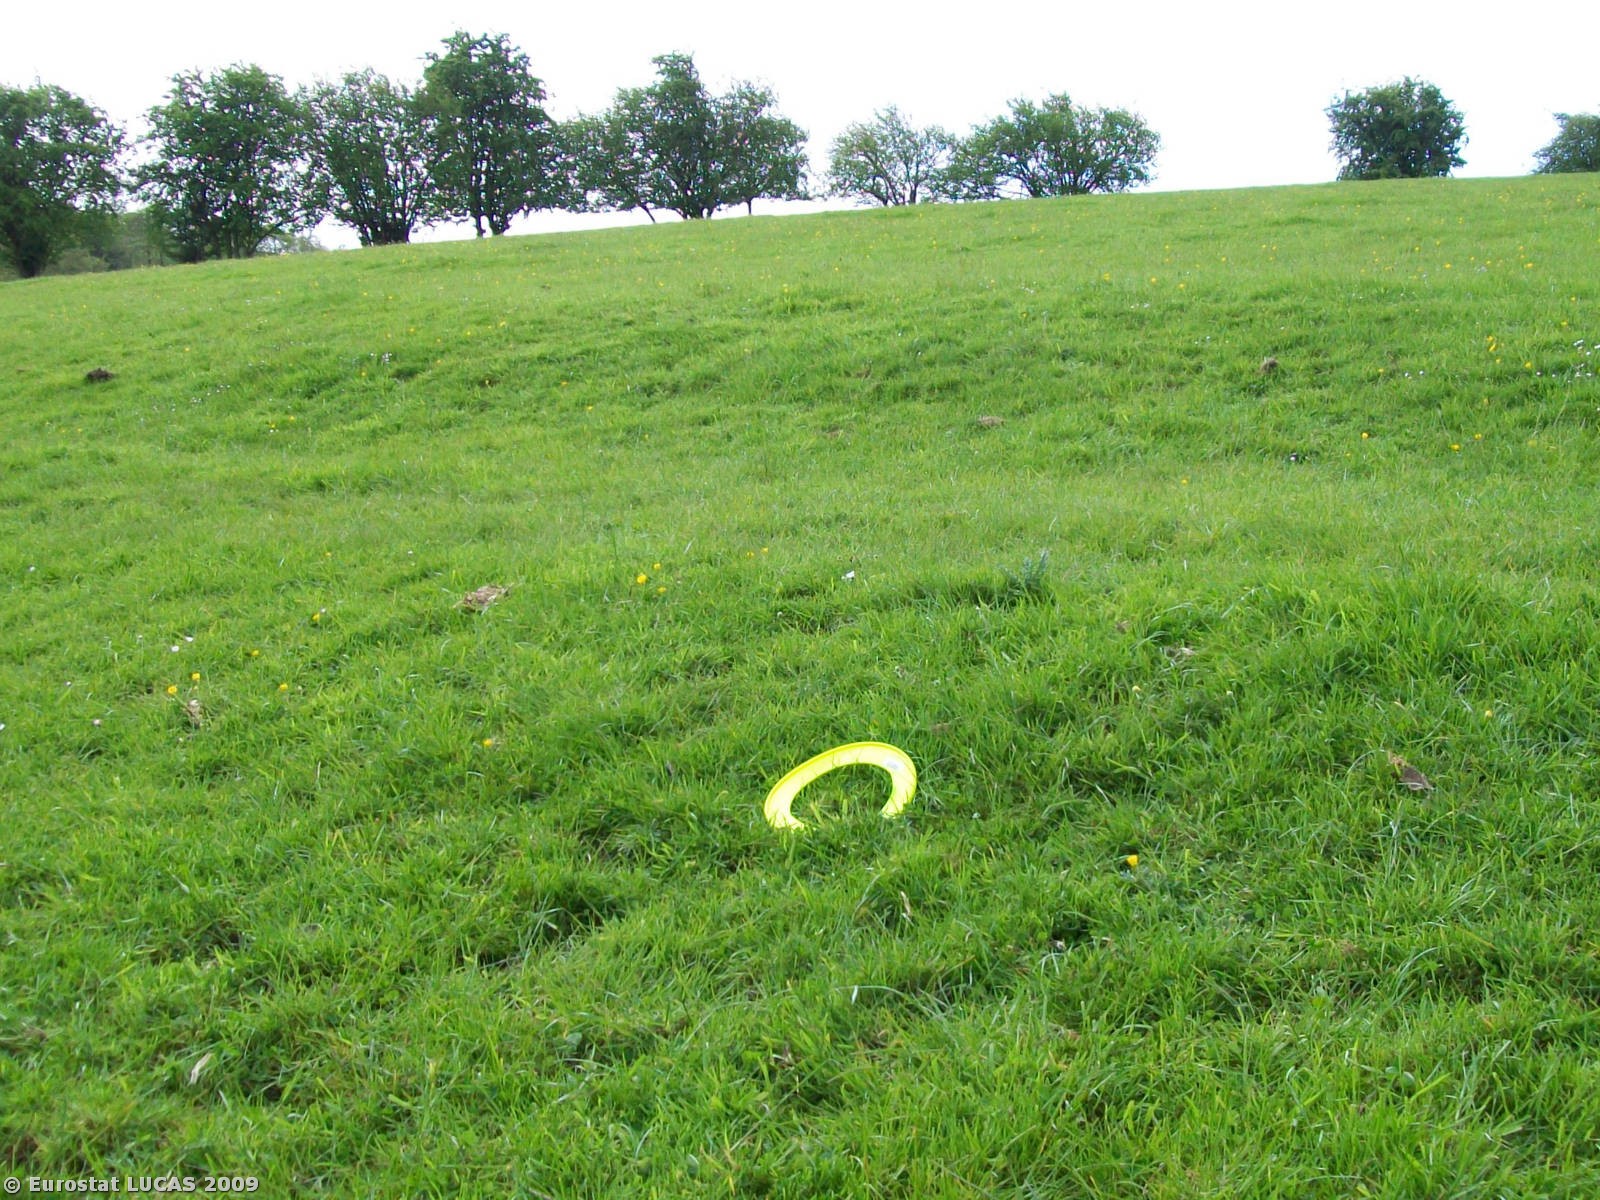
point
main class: Grassland
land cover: Grassland without tree/shrub cover
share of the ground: > 75 %
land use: Agriculture (excluding fallow land and kitchen gardens)
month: May
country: GB
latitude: 52.2974
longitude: -2.4860
